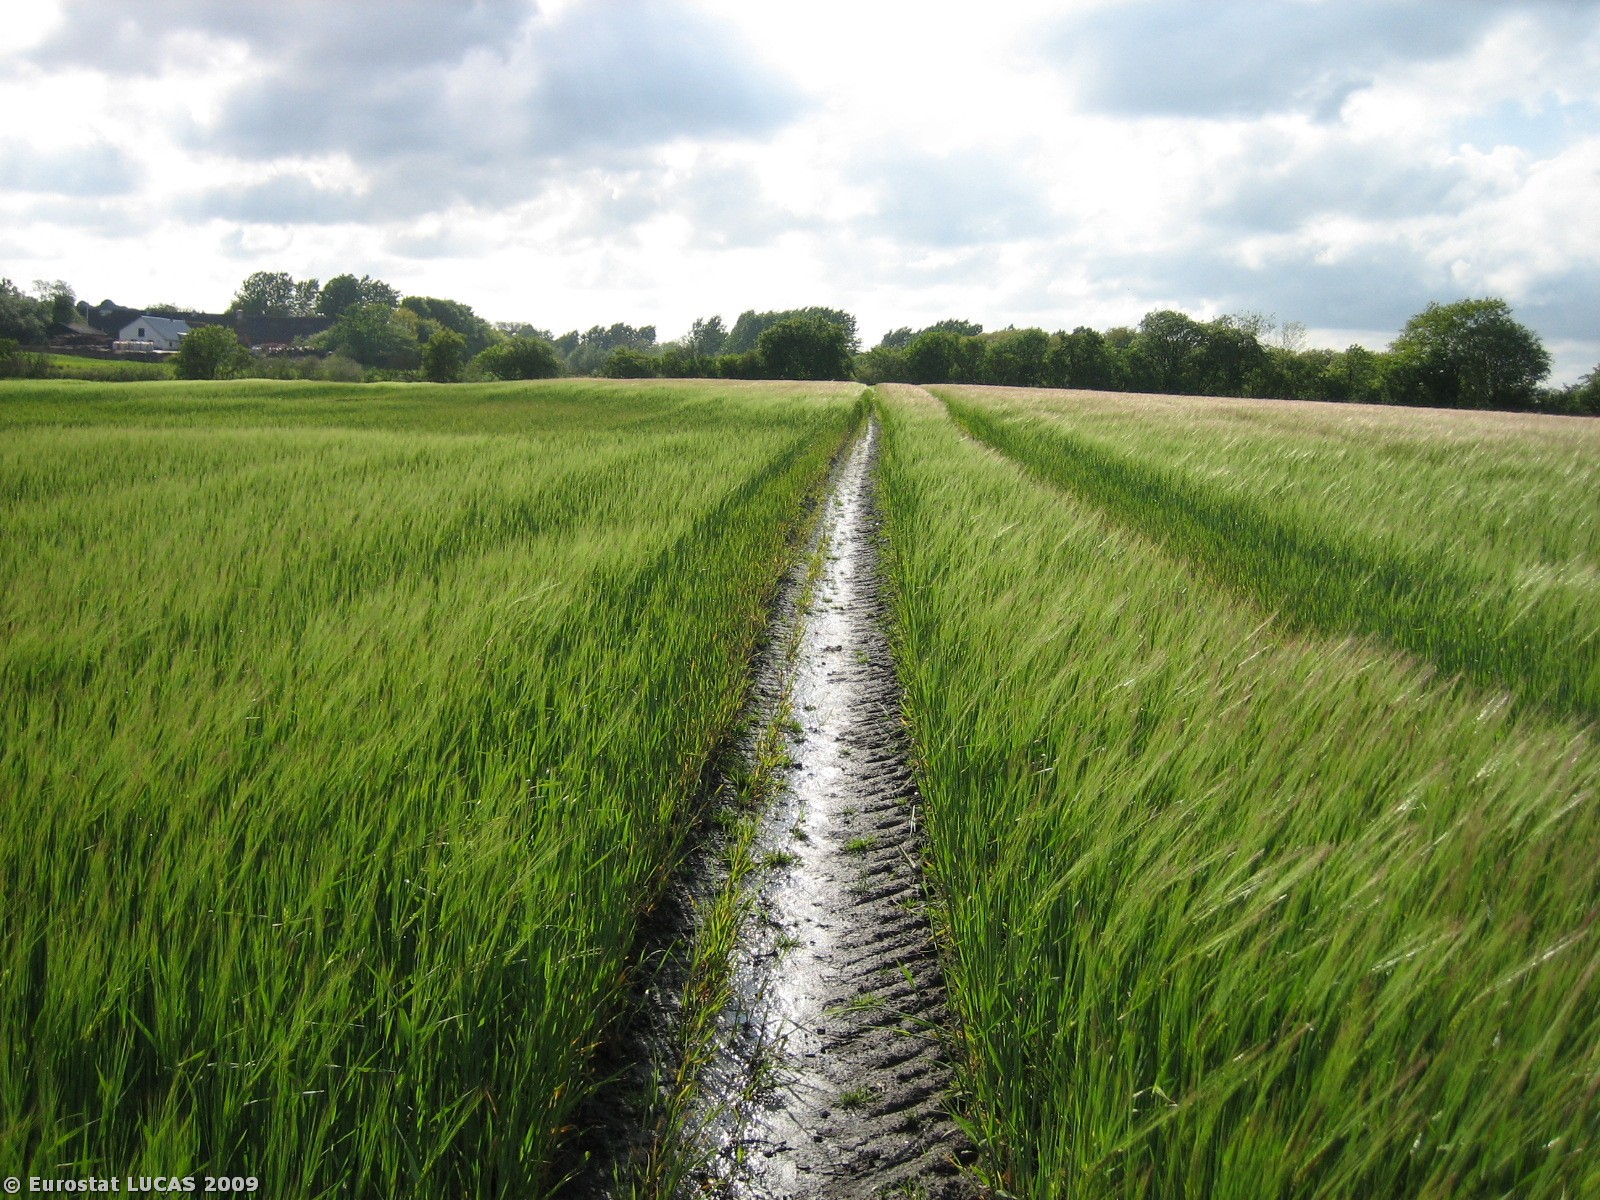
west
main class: Cropland
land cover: Barley
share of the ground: > 75 %
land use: Agriculture (excluding fallow land and kitchen gardens)
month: May
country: DK
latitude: 56.1814
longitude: 8.7287
